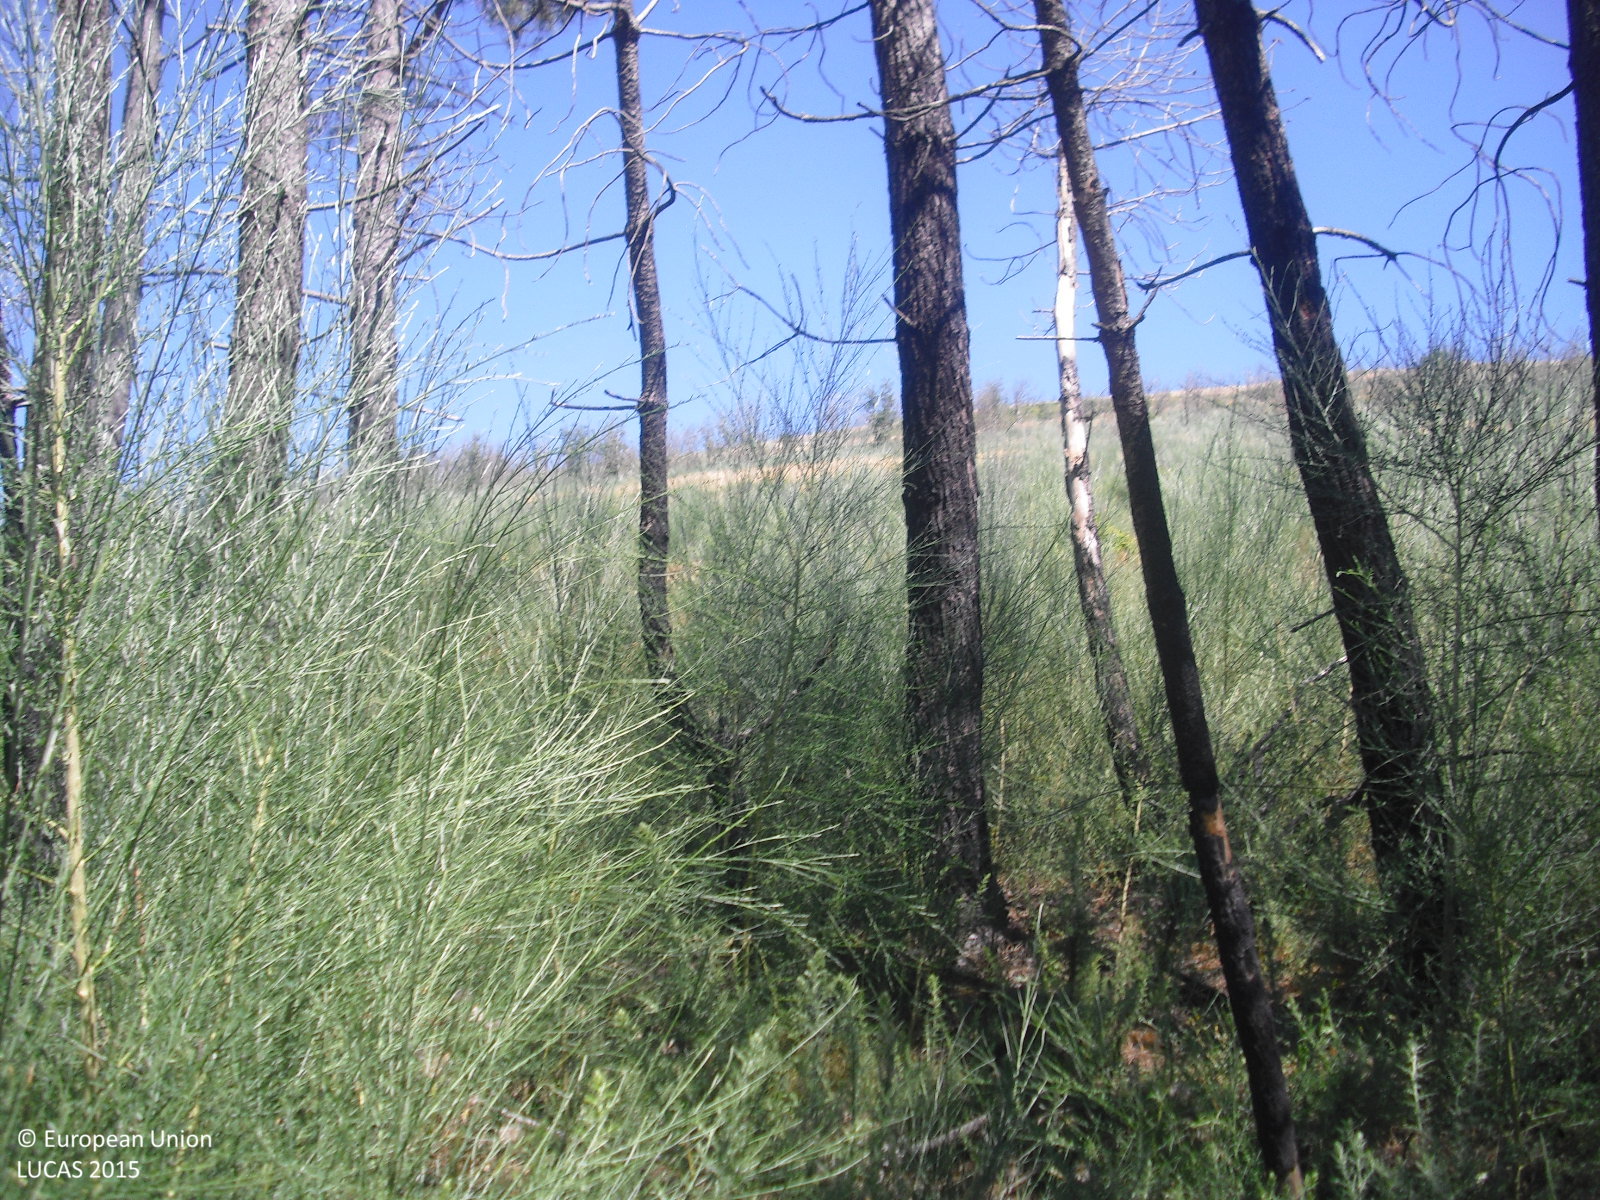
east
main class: Woodland
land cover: Pine dominated coniferous woodland
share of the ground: 10 - 25 %
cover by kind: shrubs 80 %, coniferous forest trees 20 %
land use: Forestry
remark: Burnt area
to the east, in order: Pine dominated coniferous woodland; Shrubland with sparse tree cover; Shrubland without tree cover; Dry stone walls; Shrubland without tree cover; Shrubland with sparse tree cover; Dry stone walls; Shrubland with sparse tree cover; Dry stone walls; Shrubland with sparse tree cover
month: June
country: ES
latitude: 42.6270
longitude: -7.9213
